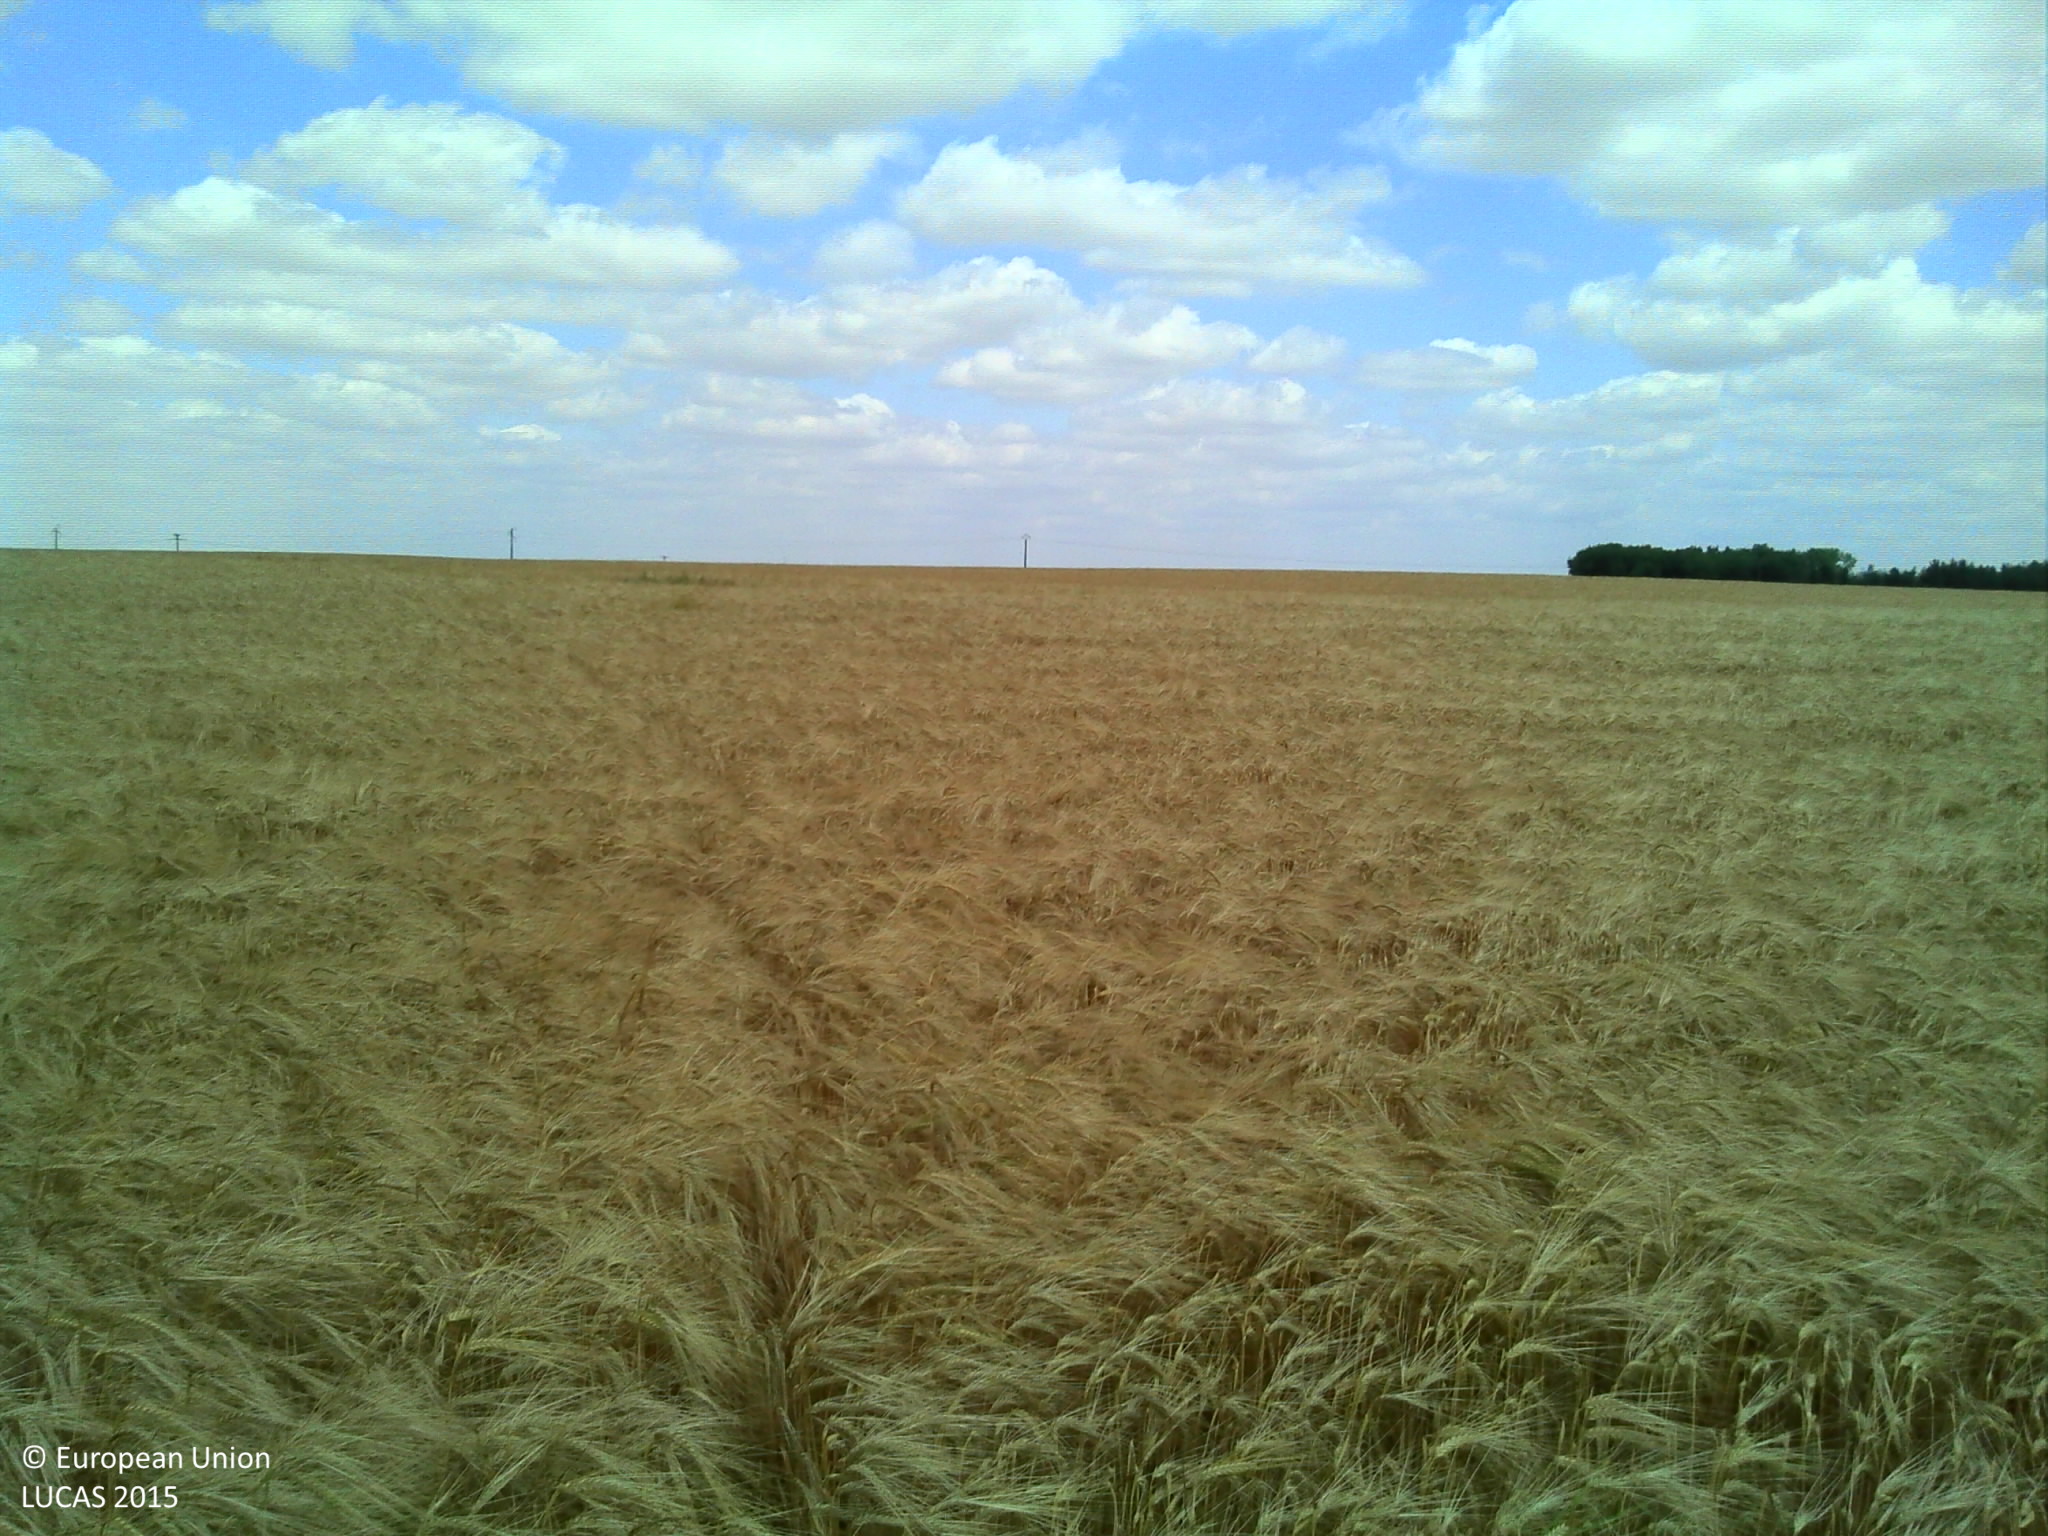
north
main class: Cropland
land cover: Barley
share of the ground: > 75 %
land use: Agriculture (excluding fallow land and kitchen gardens)
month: July
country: FR
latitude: 48.0970
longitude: 2.5381
